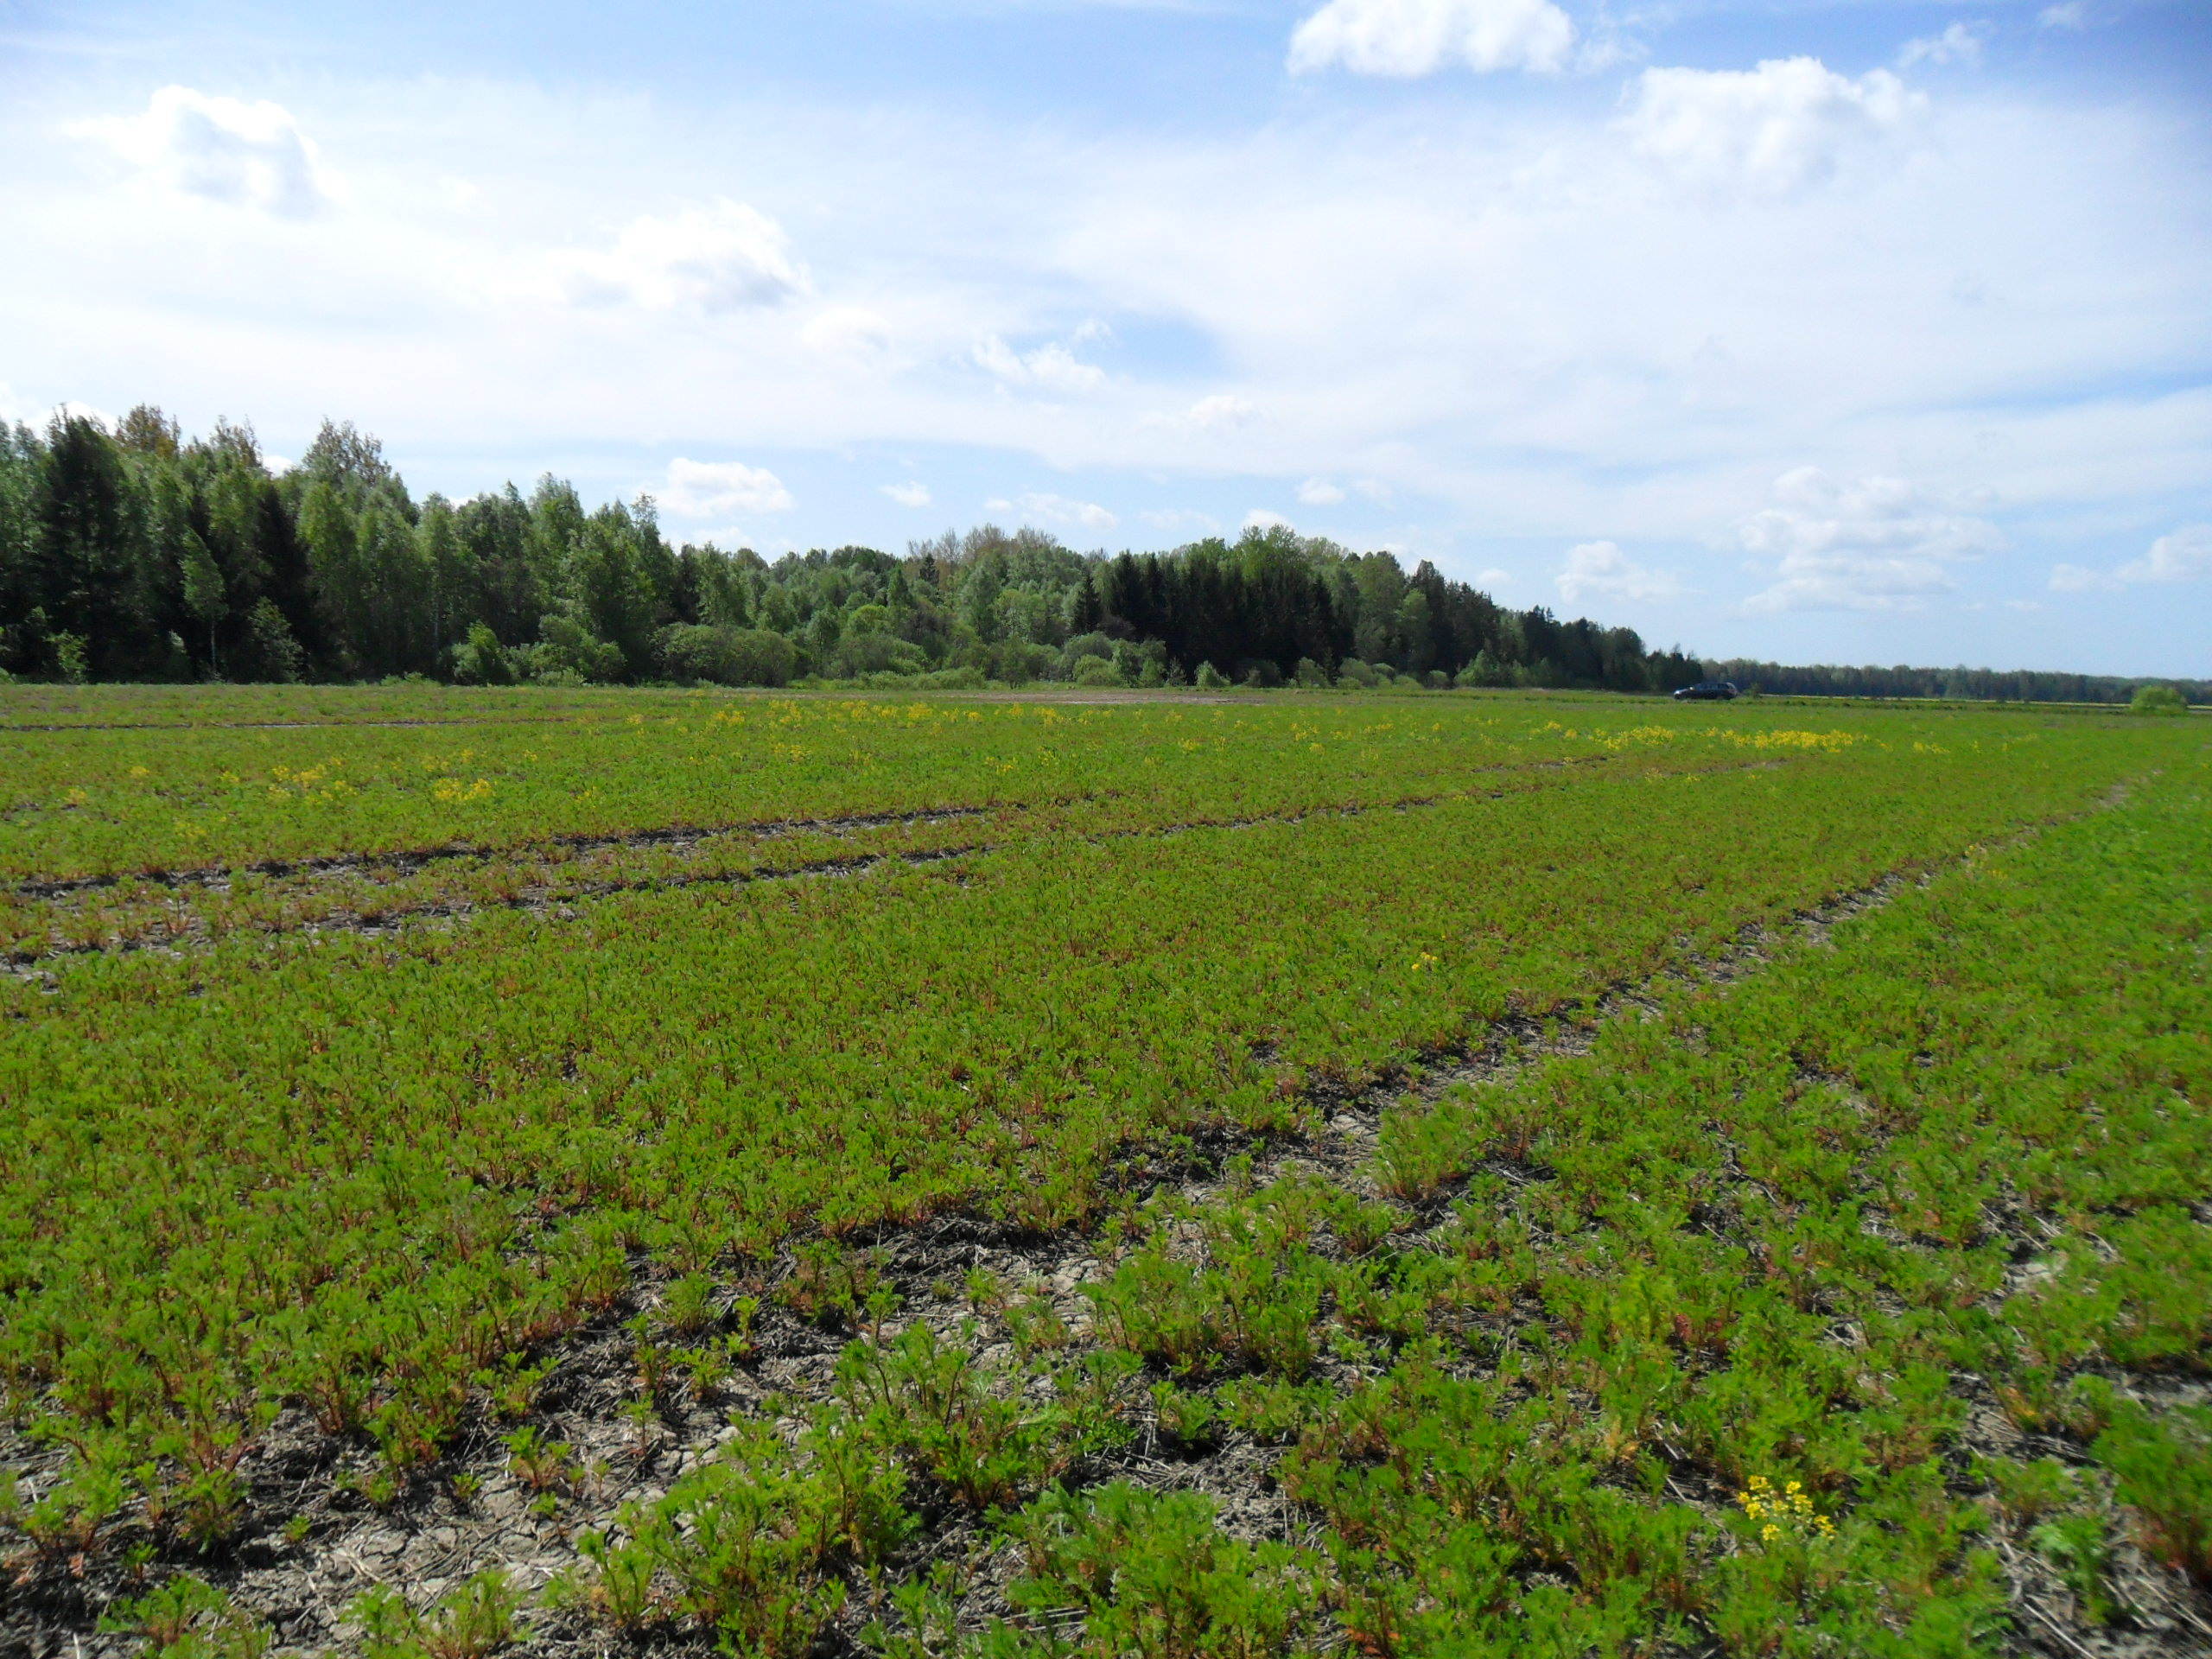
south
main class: Grassland
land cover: Spontaneously vegetated surfaces
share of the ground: 25 - 50 %
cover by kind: unconsolidated bare surface 55 %, herbaceous plants 45 %
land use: Fallow land
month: May
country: LV
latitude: 57.2801
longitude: 22.3764
